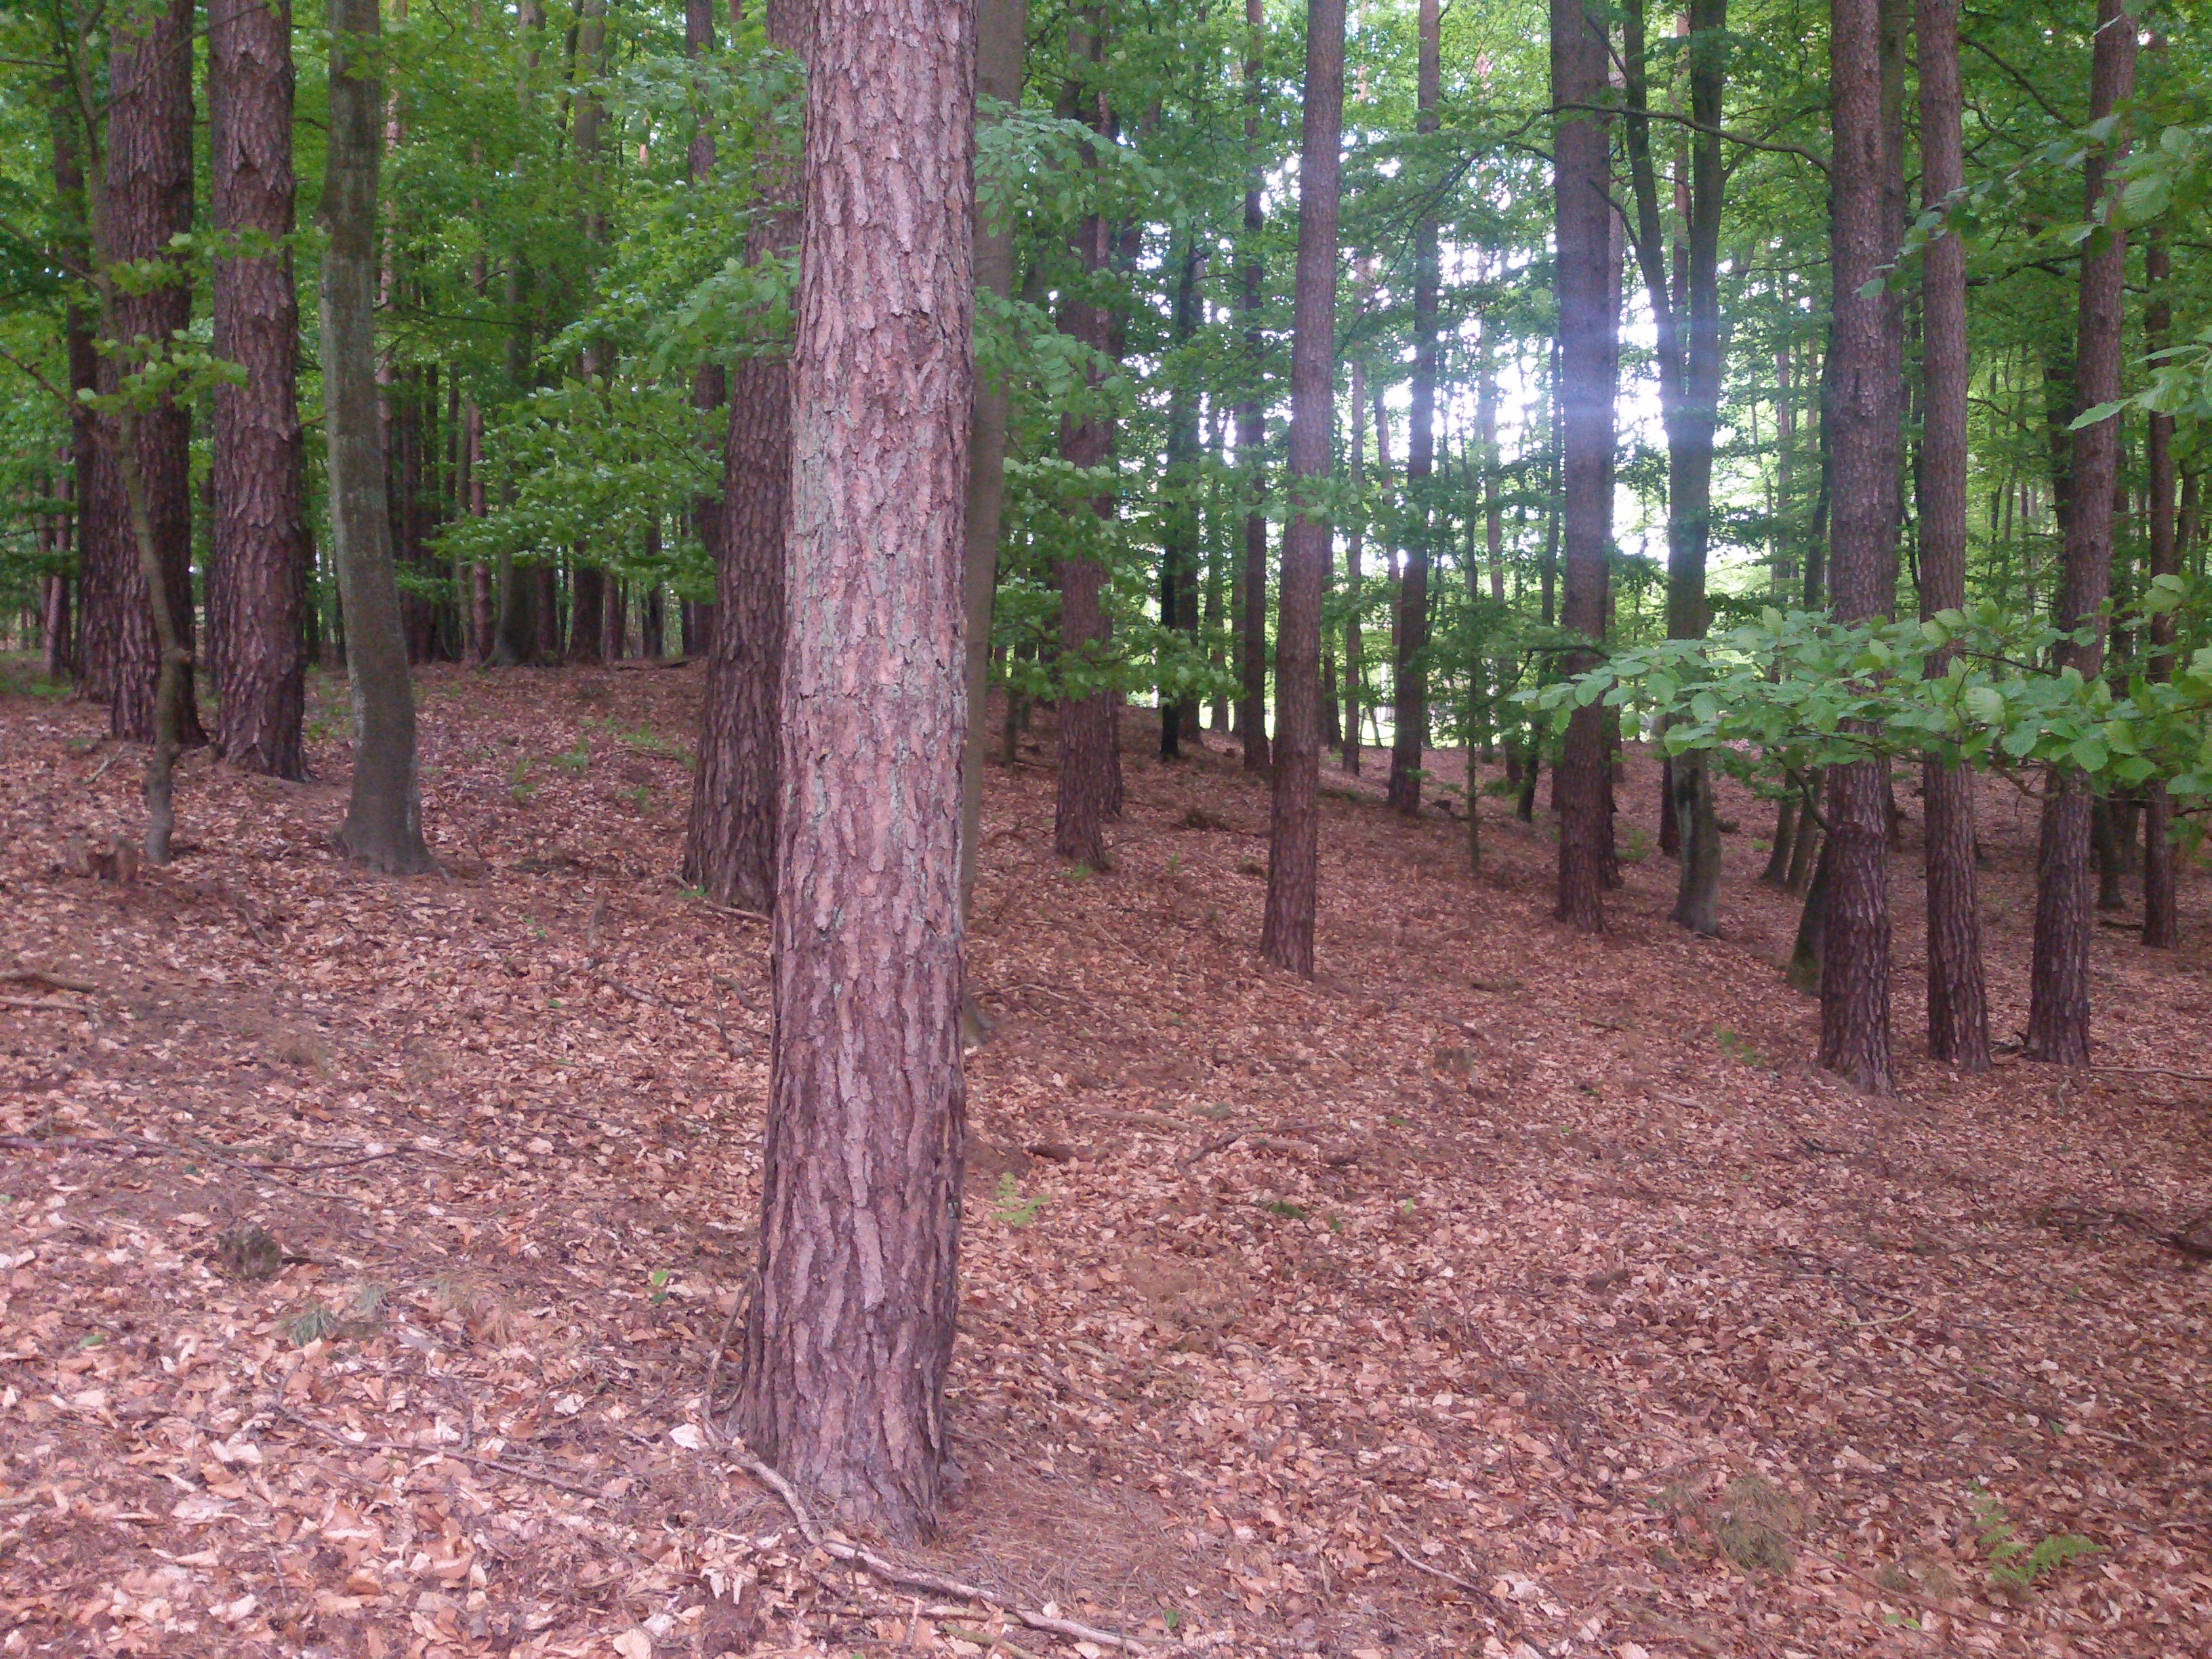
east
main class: Woodland
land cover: Pine dominated mixed woodland
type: hemiboreal forest and nemoral coniferous forest and mixed broadleaved-coniferous forest
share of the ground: > 75 %
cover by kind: coniferous forest trees 60 %, broadleaved forest trees 40 %
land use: Forestry
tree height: > 5 m
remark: Nursery
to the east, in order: Pine dominated mixed woodland; Fences; Broadleaved woodland; Fences; Paved roads, cycling and walking lanes; Broadleaved woodland; Pine dominated coniferous woodland
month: May
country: PL
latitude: 53.6492
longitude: 14.3123
